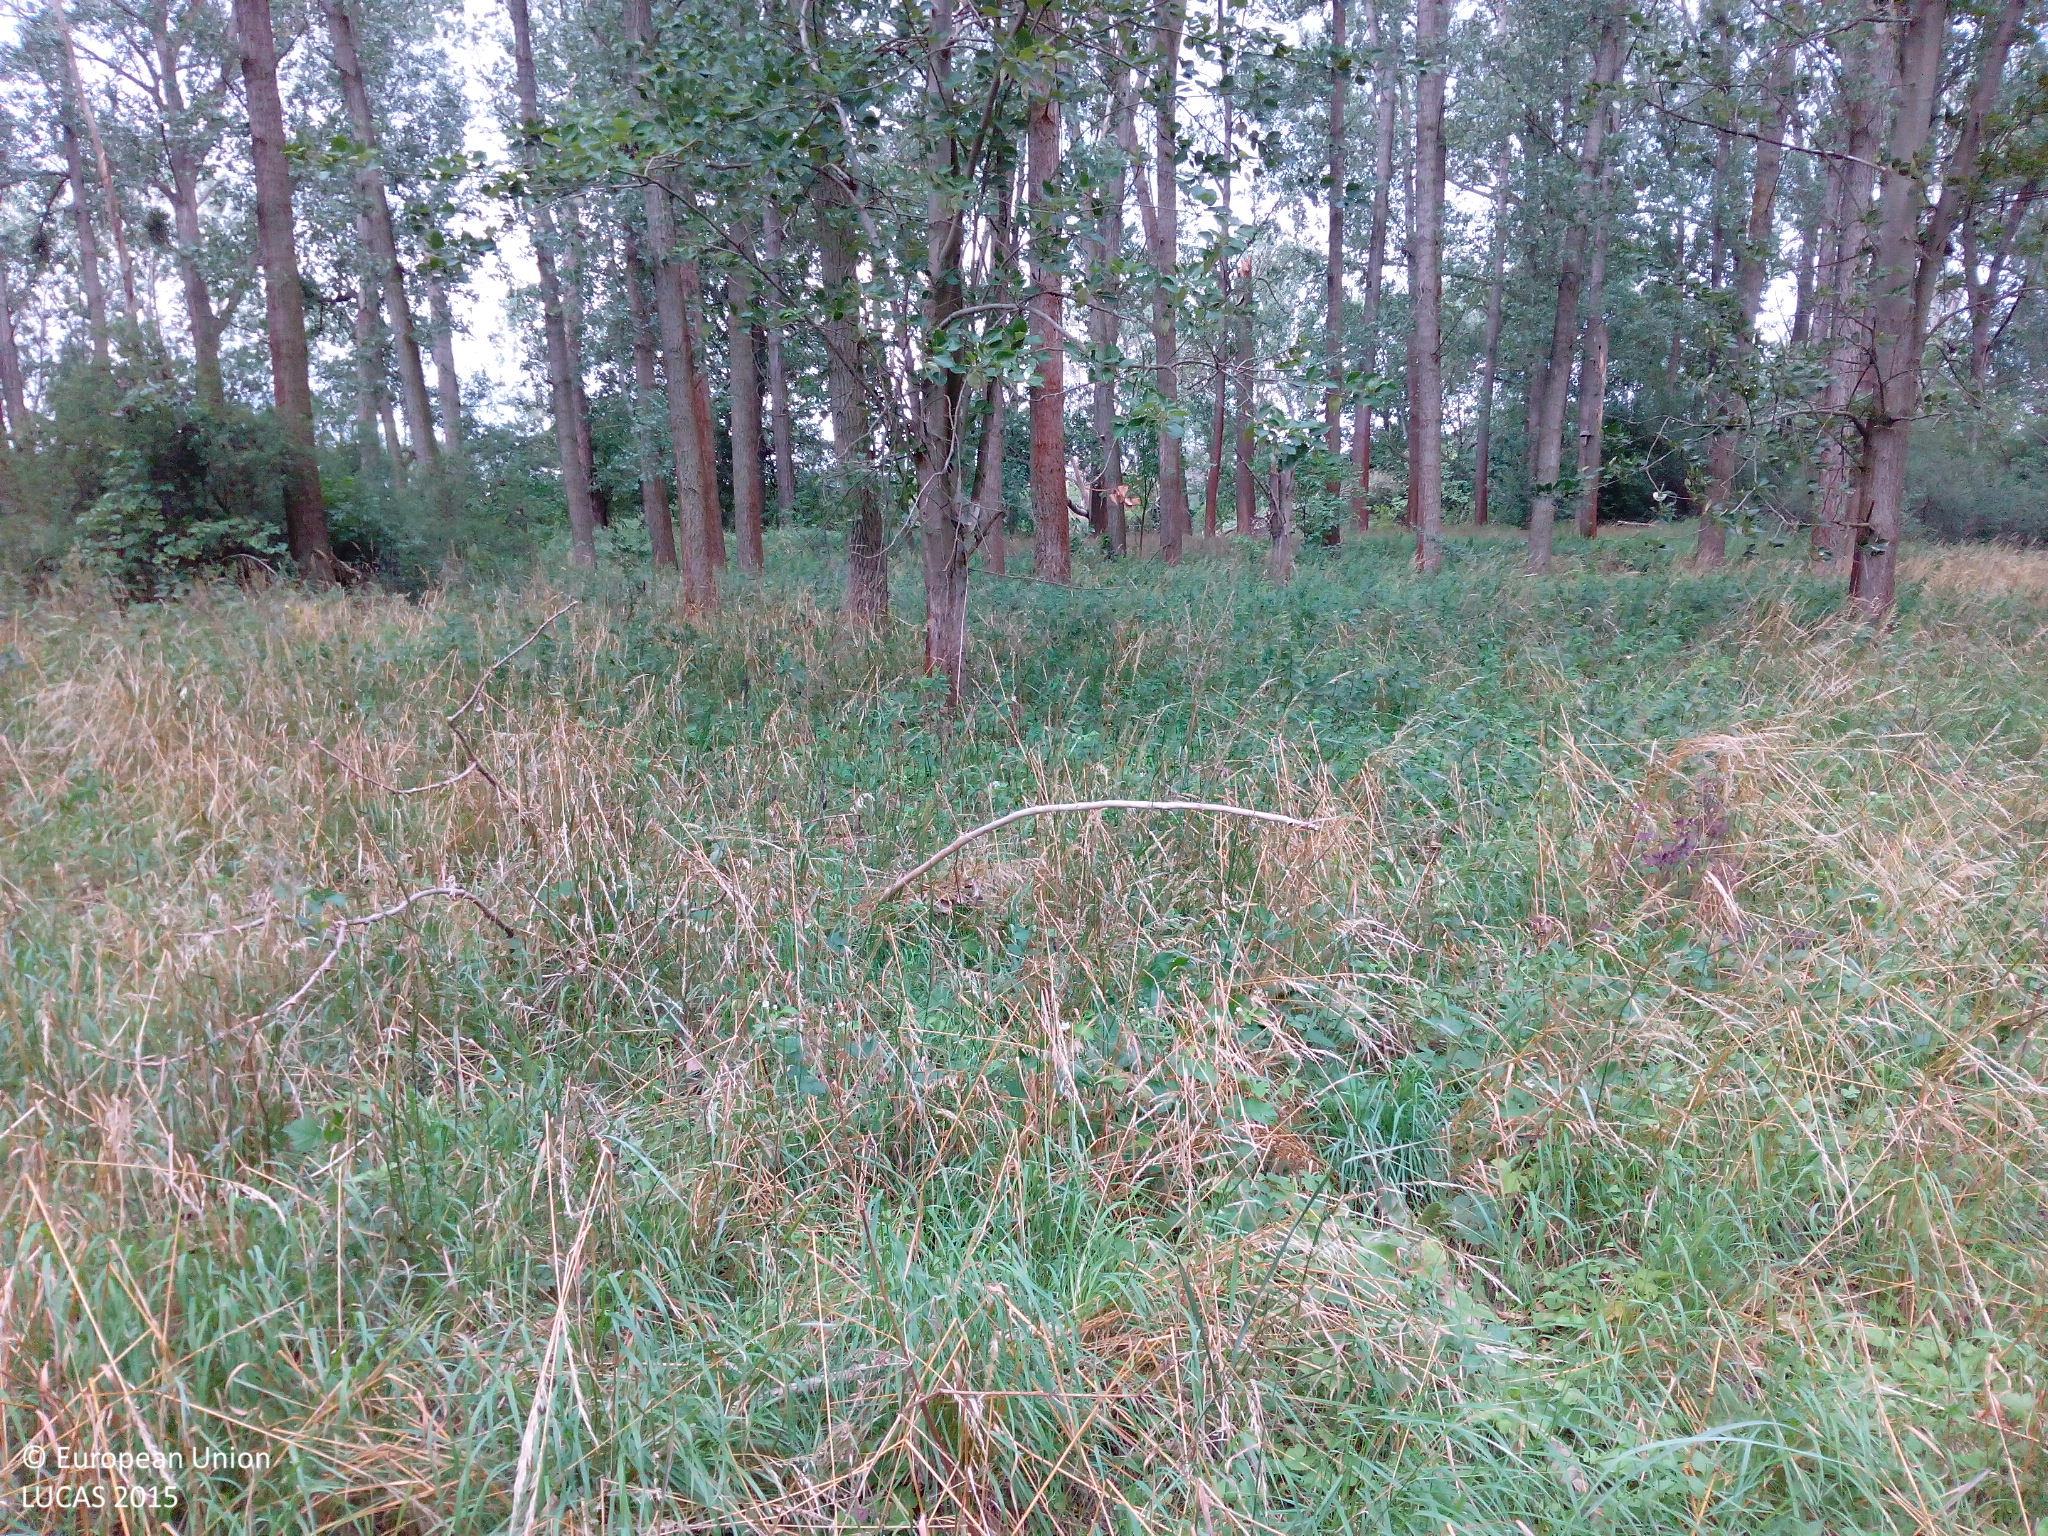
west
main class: Woodland
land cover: Broadleaved woodland
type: mesophytic deciduous forest
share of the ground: > 75 %
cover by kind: broadleaved forest trees 75 %, herbaceous plants 25 %
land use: Forestry
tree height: > 5 m
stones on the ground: < 10 %
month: July
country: DE
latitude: 52.7375
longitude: 14.1331
